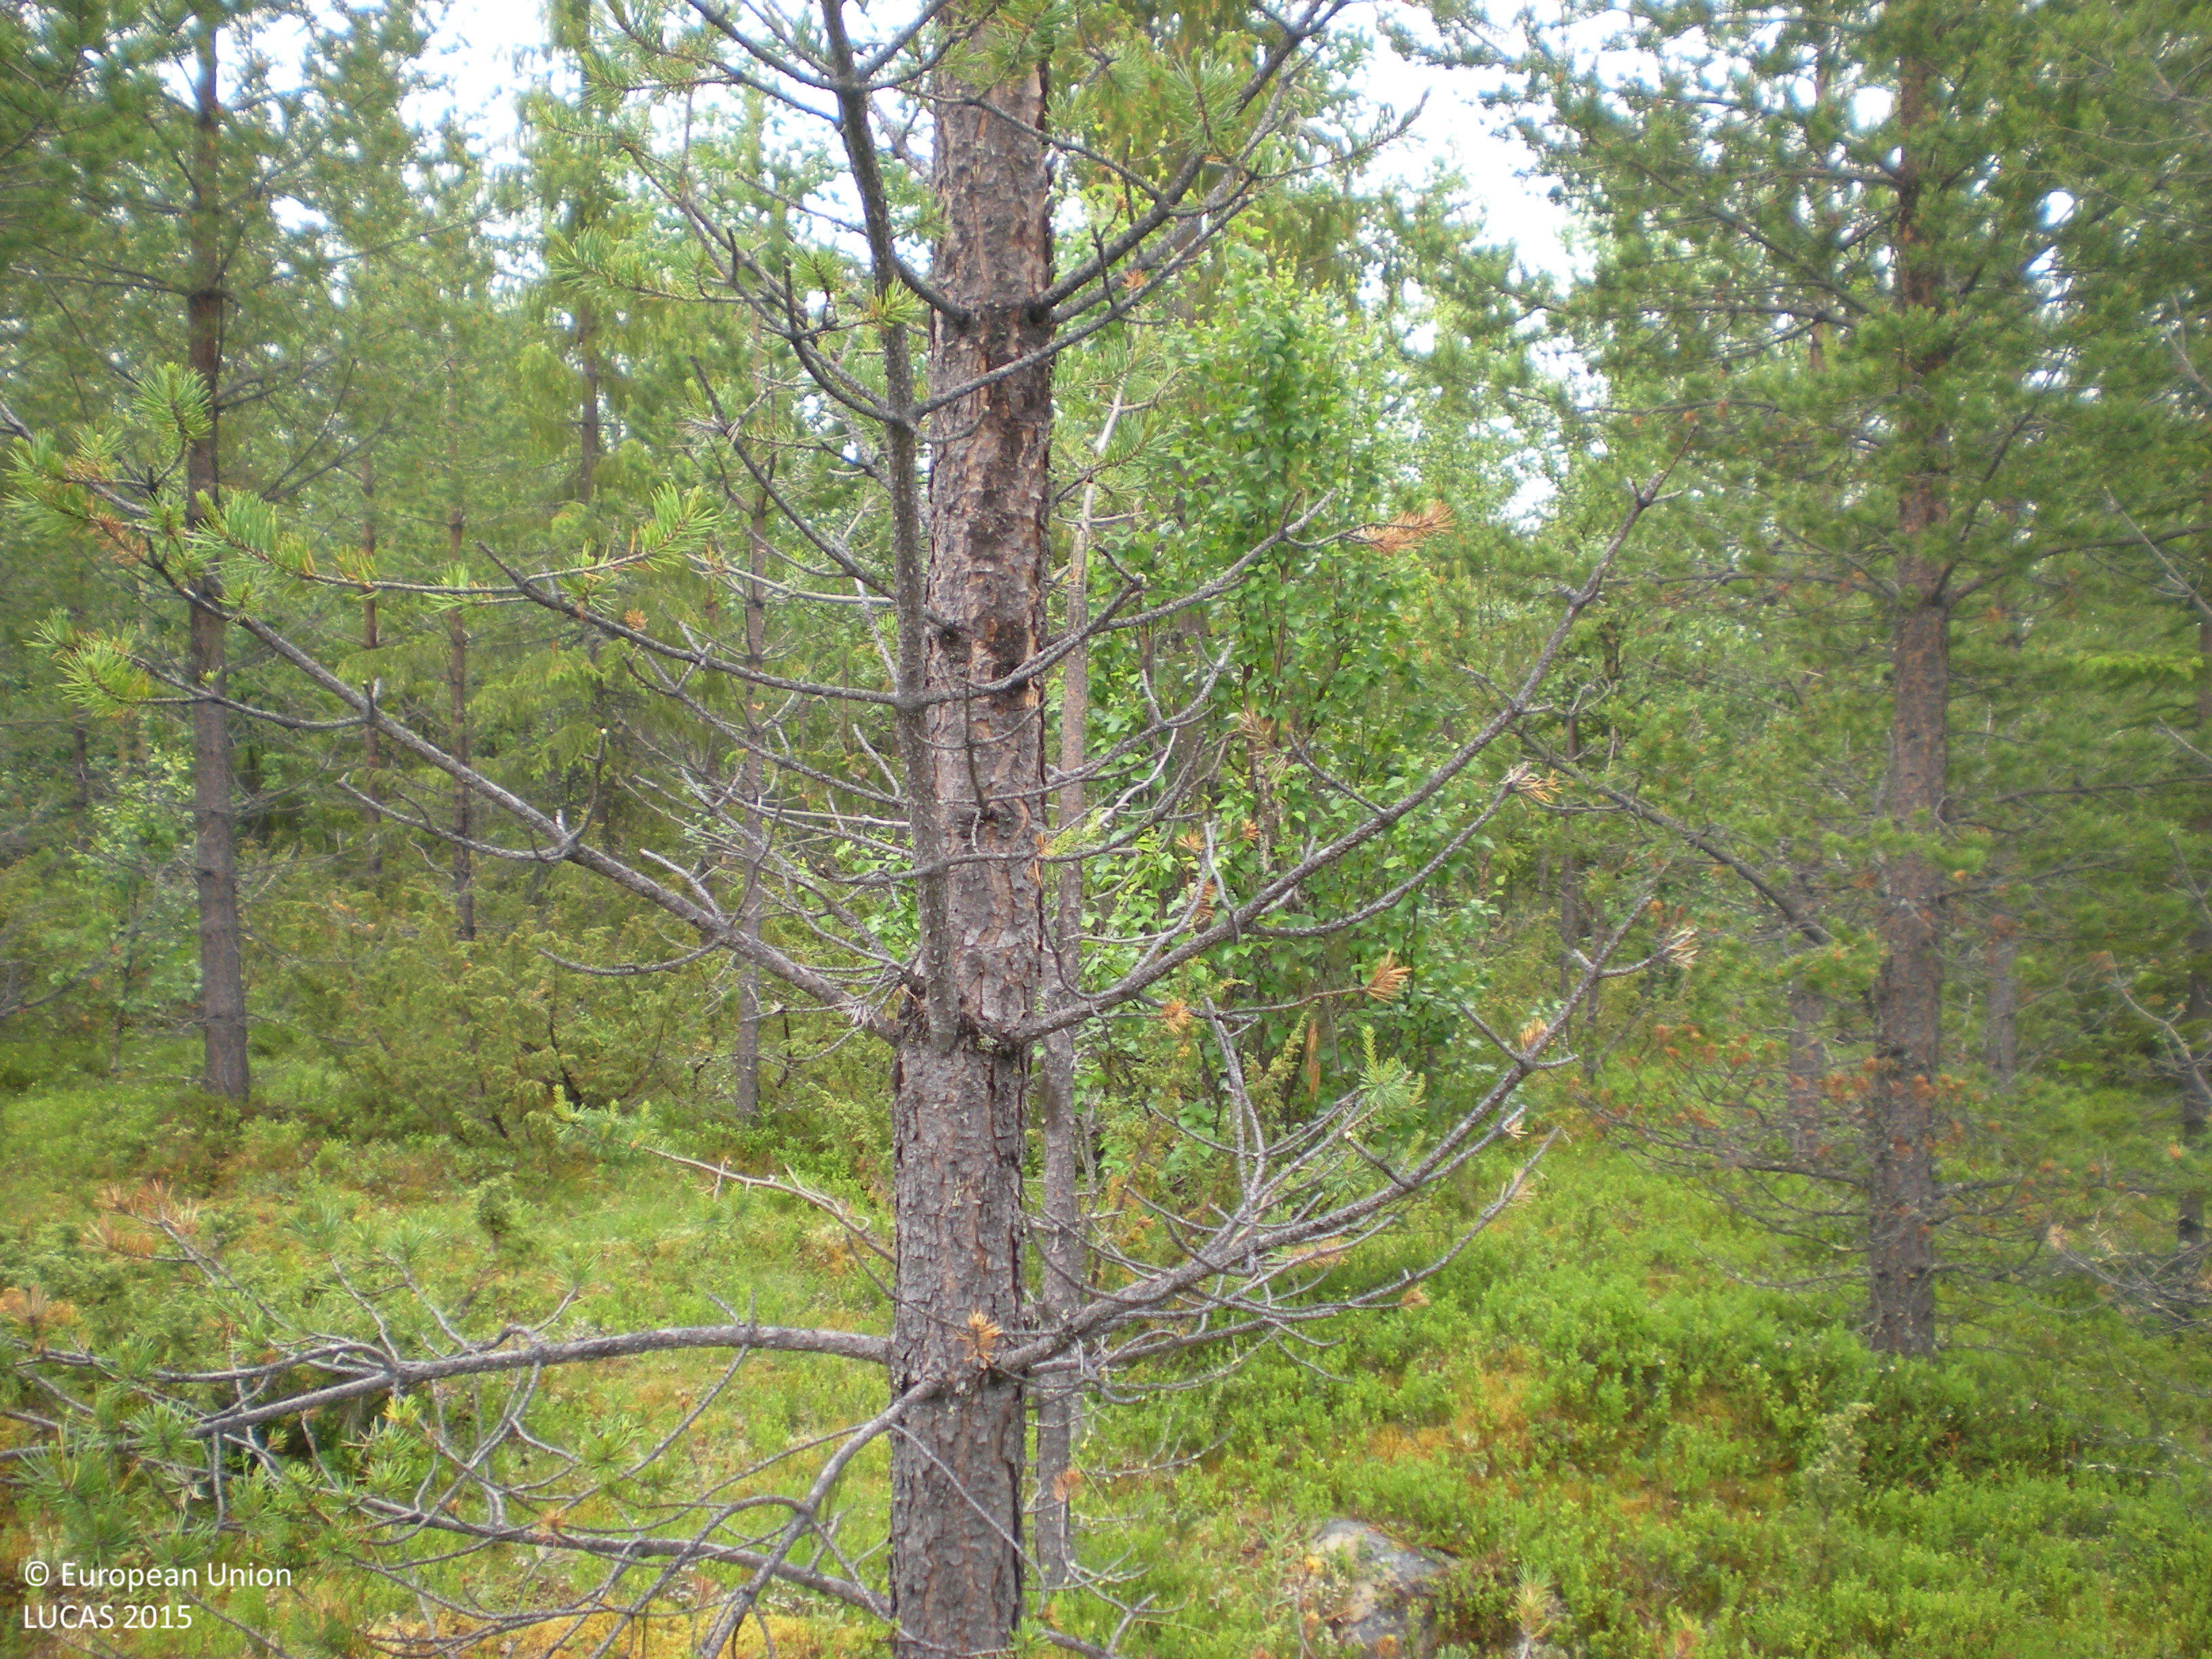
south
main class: Woodland
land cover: Pine dominated mixed woodland
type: boreal forest
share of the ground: 50 - 75 %
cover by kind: coniferous forest trees 45 %, shrubs 30 %, broadleaved forest trees 15 %, lichens and mosses 10 %
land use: Forestry
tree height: > 5 m
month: July
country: SE
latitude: 65.7566
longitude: 17.2697
